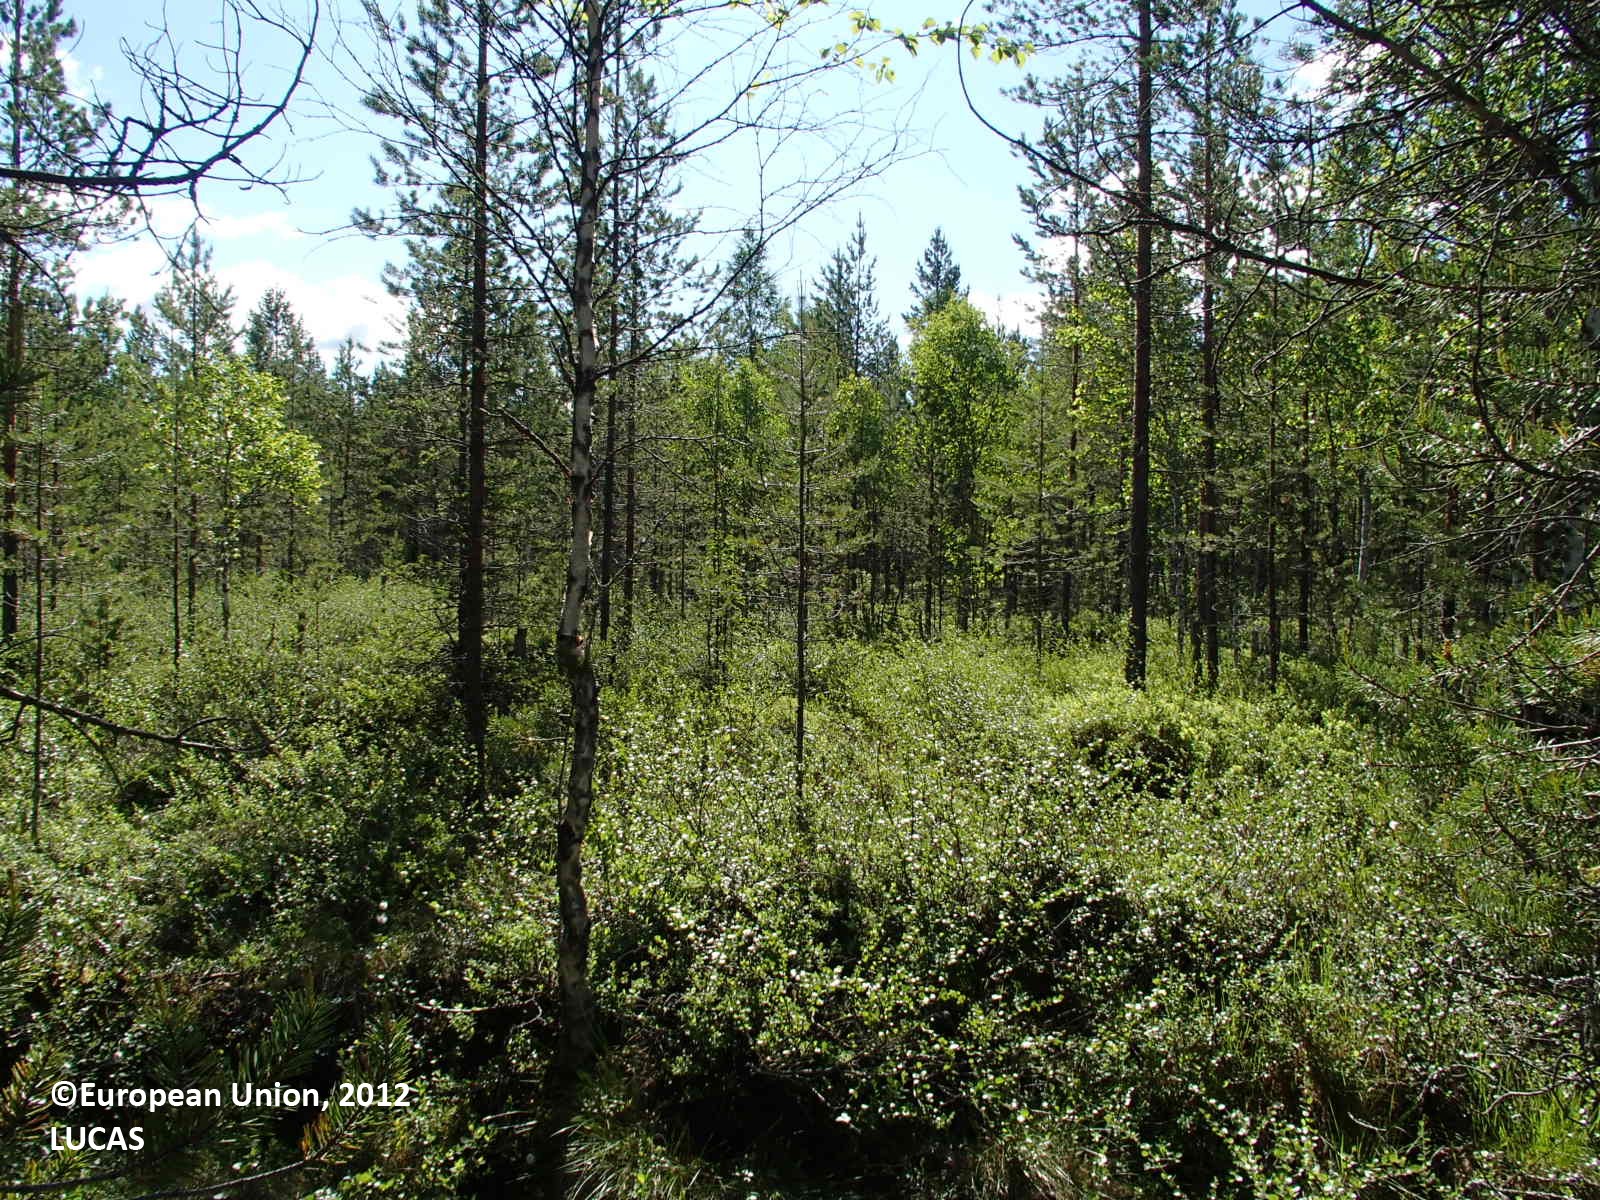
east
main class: Woodland
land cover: Pine dominated coniferous woodland
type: boreal forest
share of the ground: > 75 %
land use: Forestry
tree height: > 5 m
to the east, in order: Pine dominated coniferous woodland; Ditches and canals; Pine dominated coniferous woodland; Ditches and canals; Pine dominated coniferous woodland; Ditches and canals; Pine dominated coniferous woodland
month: June
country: FI
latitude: 64.2072
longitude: 27.5544
